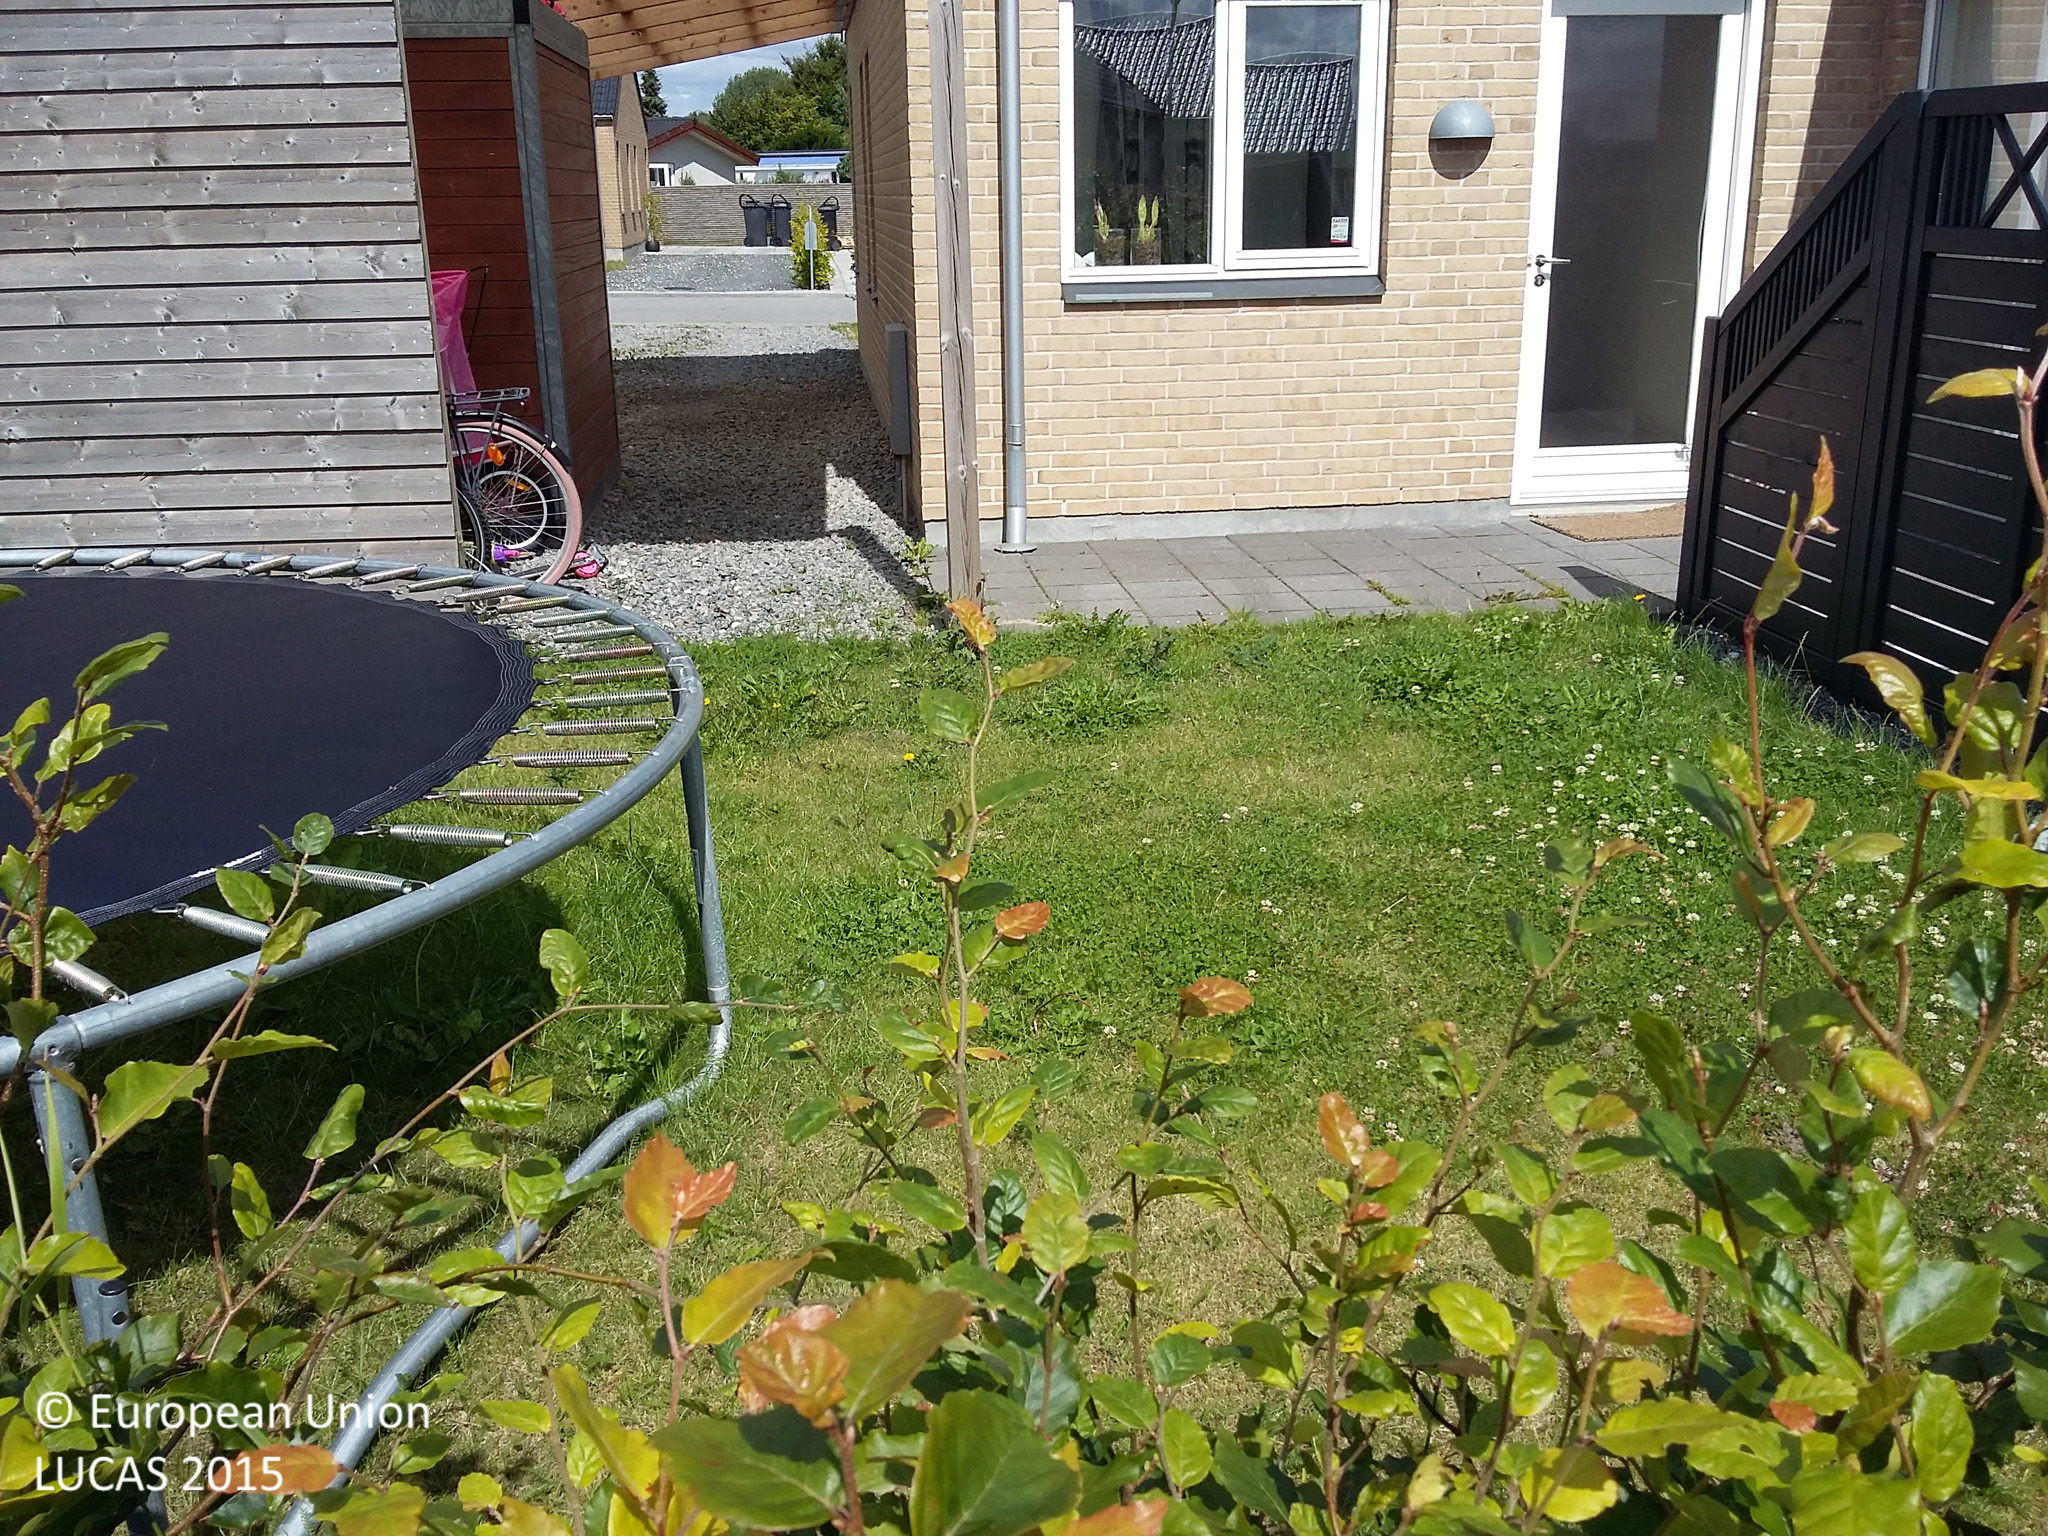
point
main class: Grassland
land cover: Grassland without tree/shrub cover
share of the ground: > 75 %
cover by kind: herbaceous plants 100 %
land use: Residential
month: August
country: DK
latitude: 55.4127
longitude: 12.2571
